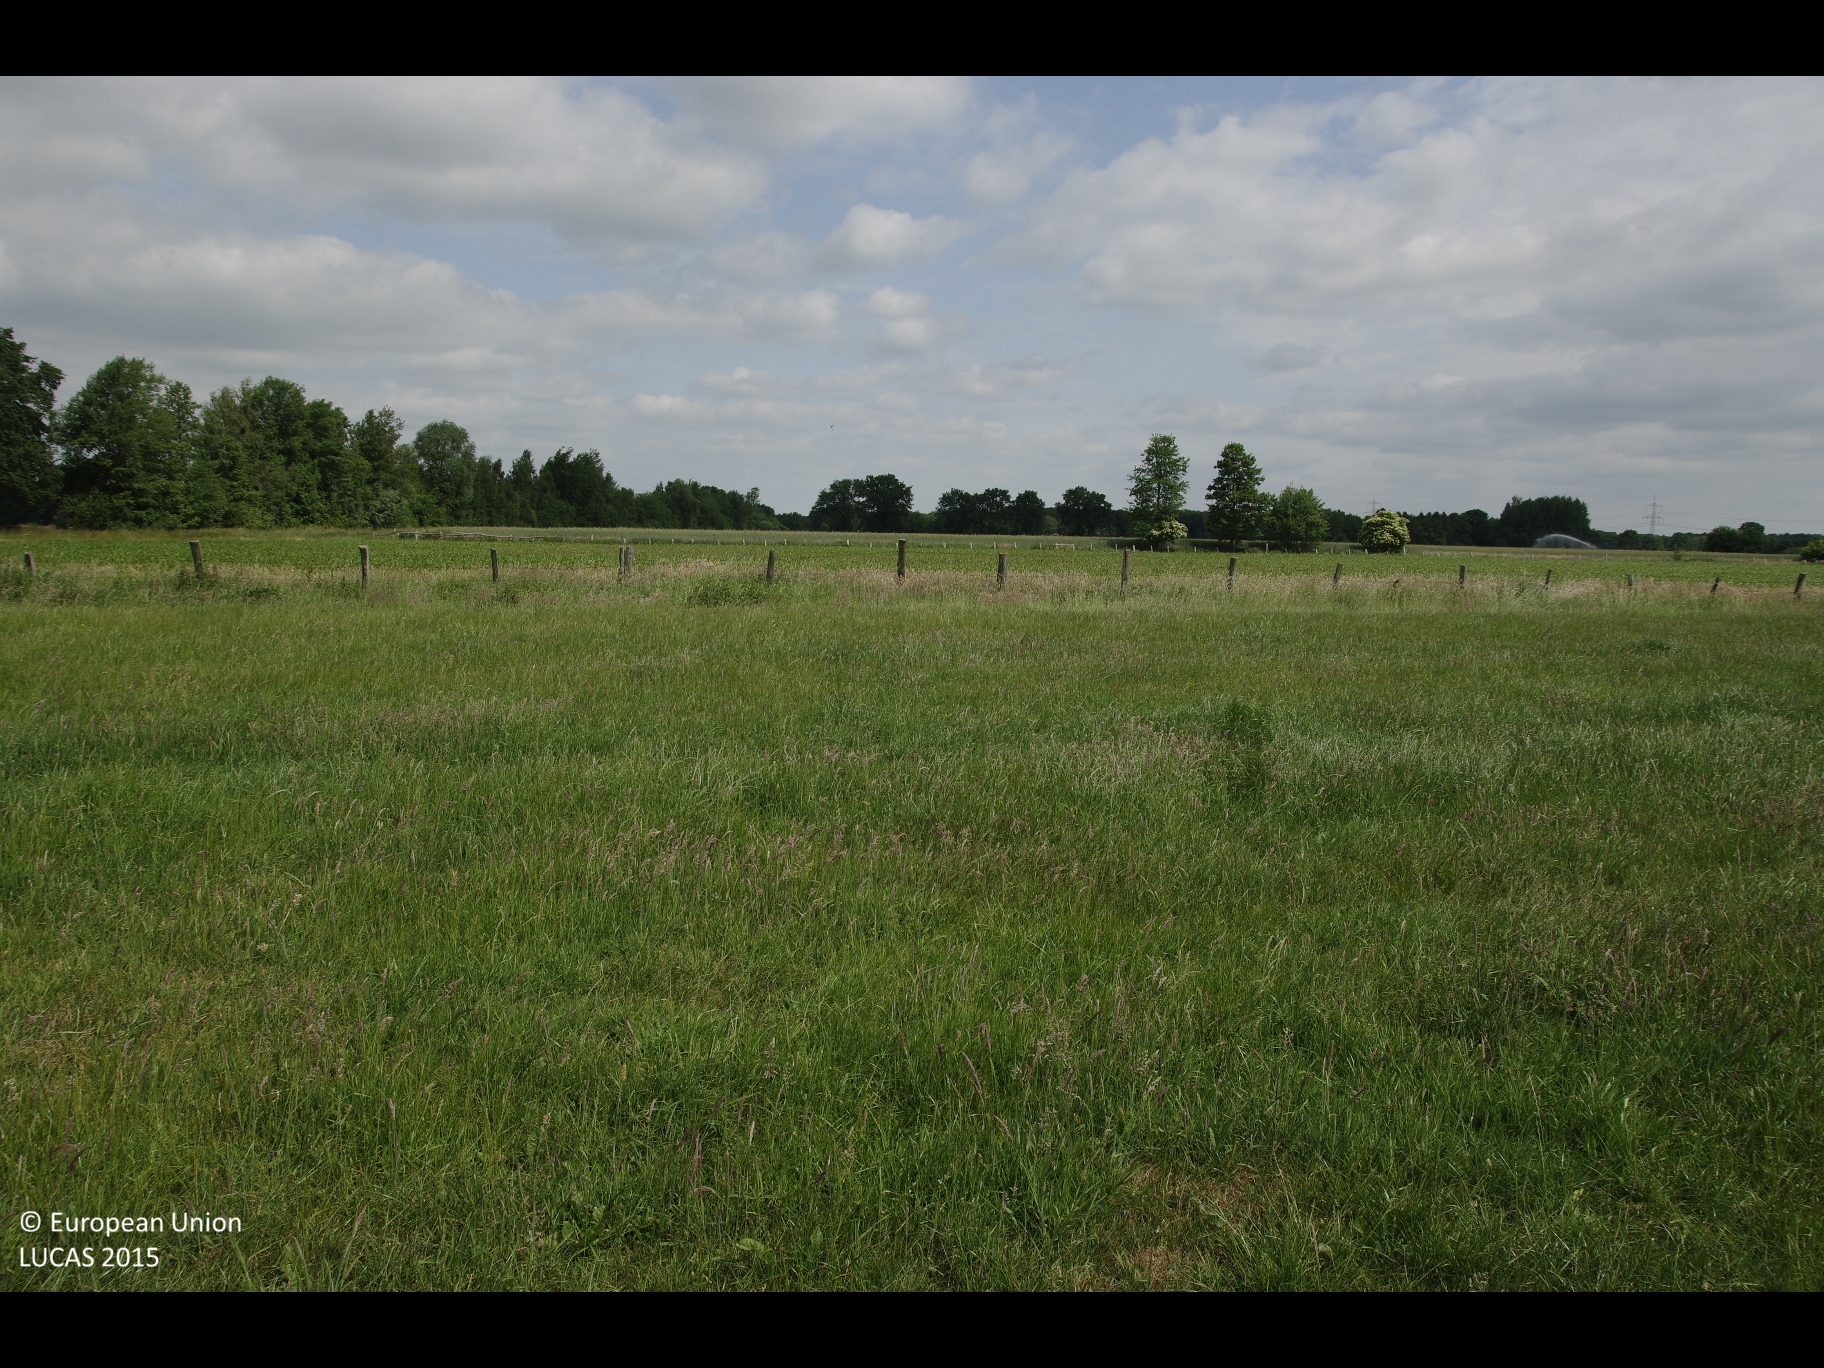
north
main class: Grassland
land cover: Grassland without tree/shrub cover
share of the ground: > 75 %
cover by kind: herbaceous plants 100 %
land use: Agriculture (excluding fallow land and kitchen gardens)
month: June
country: DE
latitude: 53.3296
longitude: 10.3152
